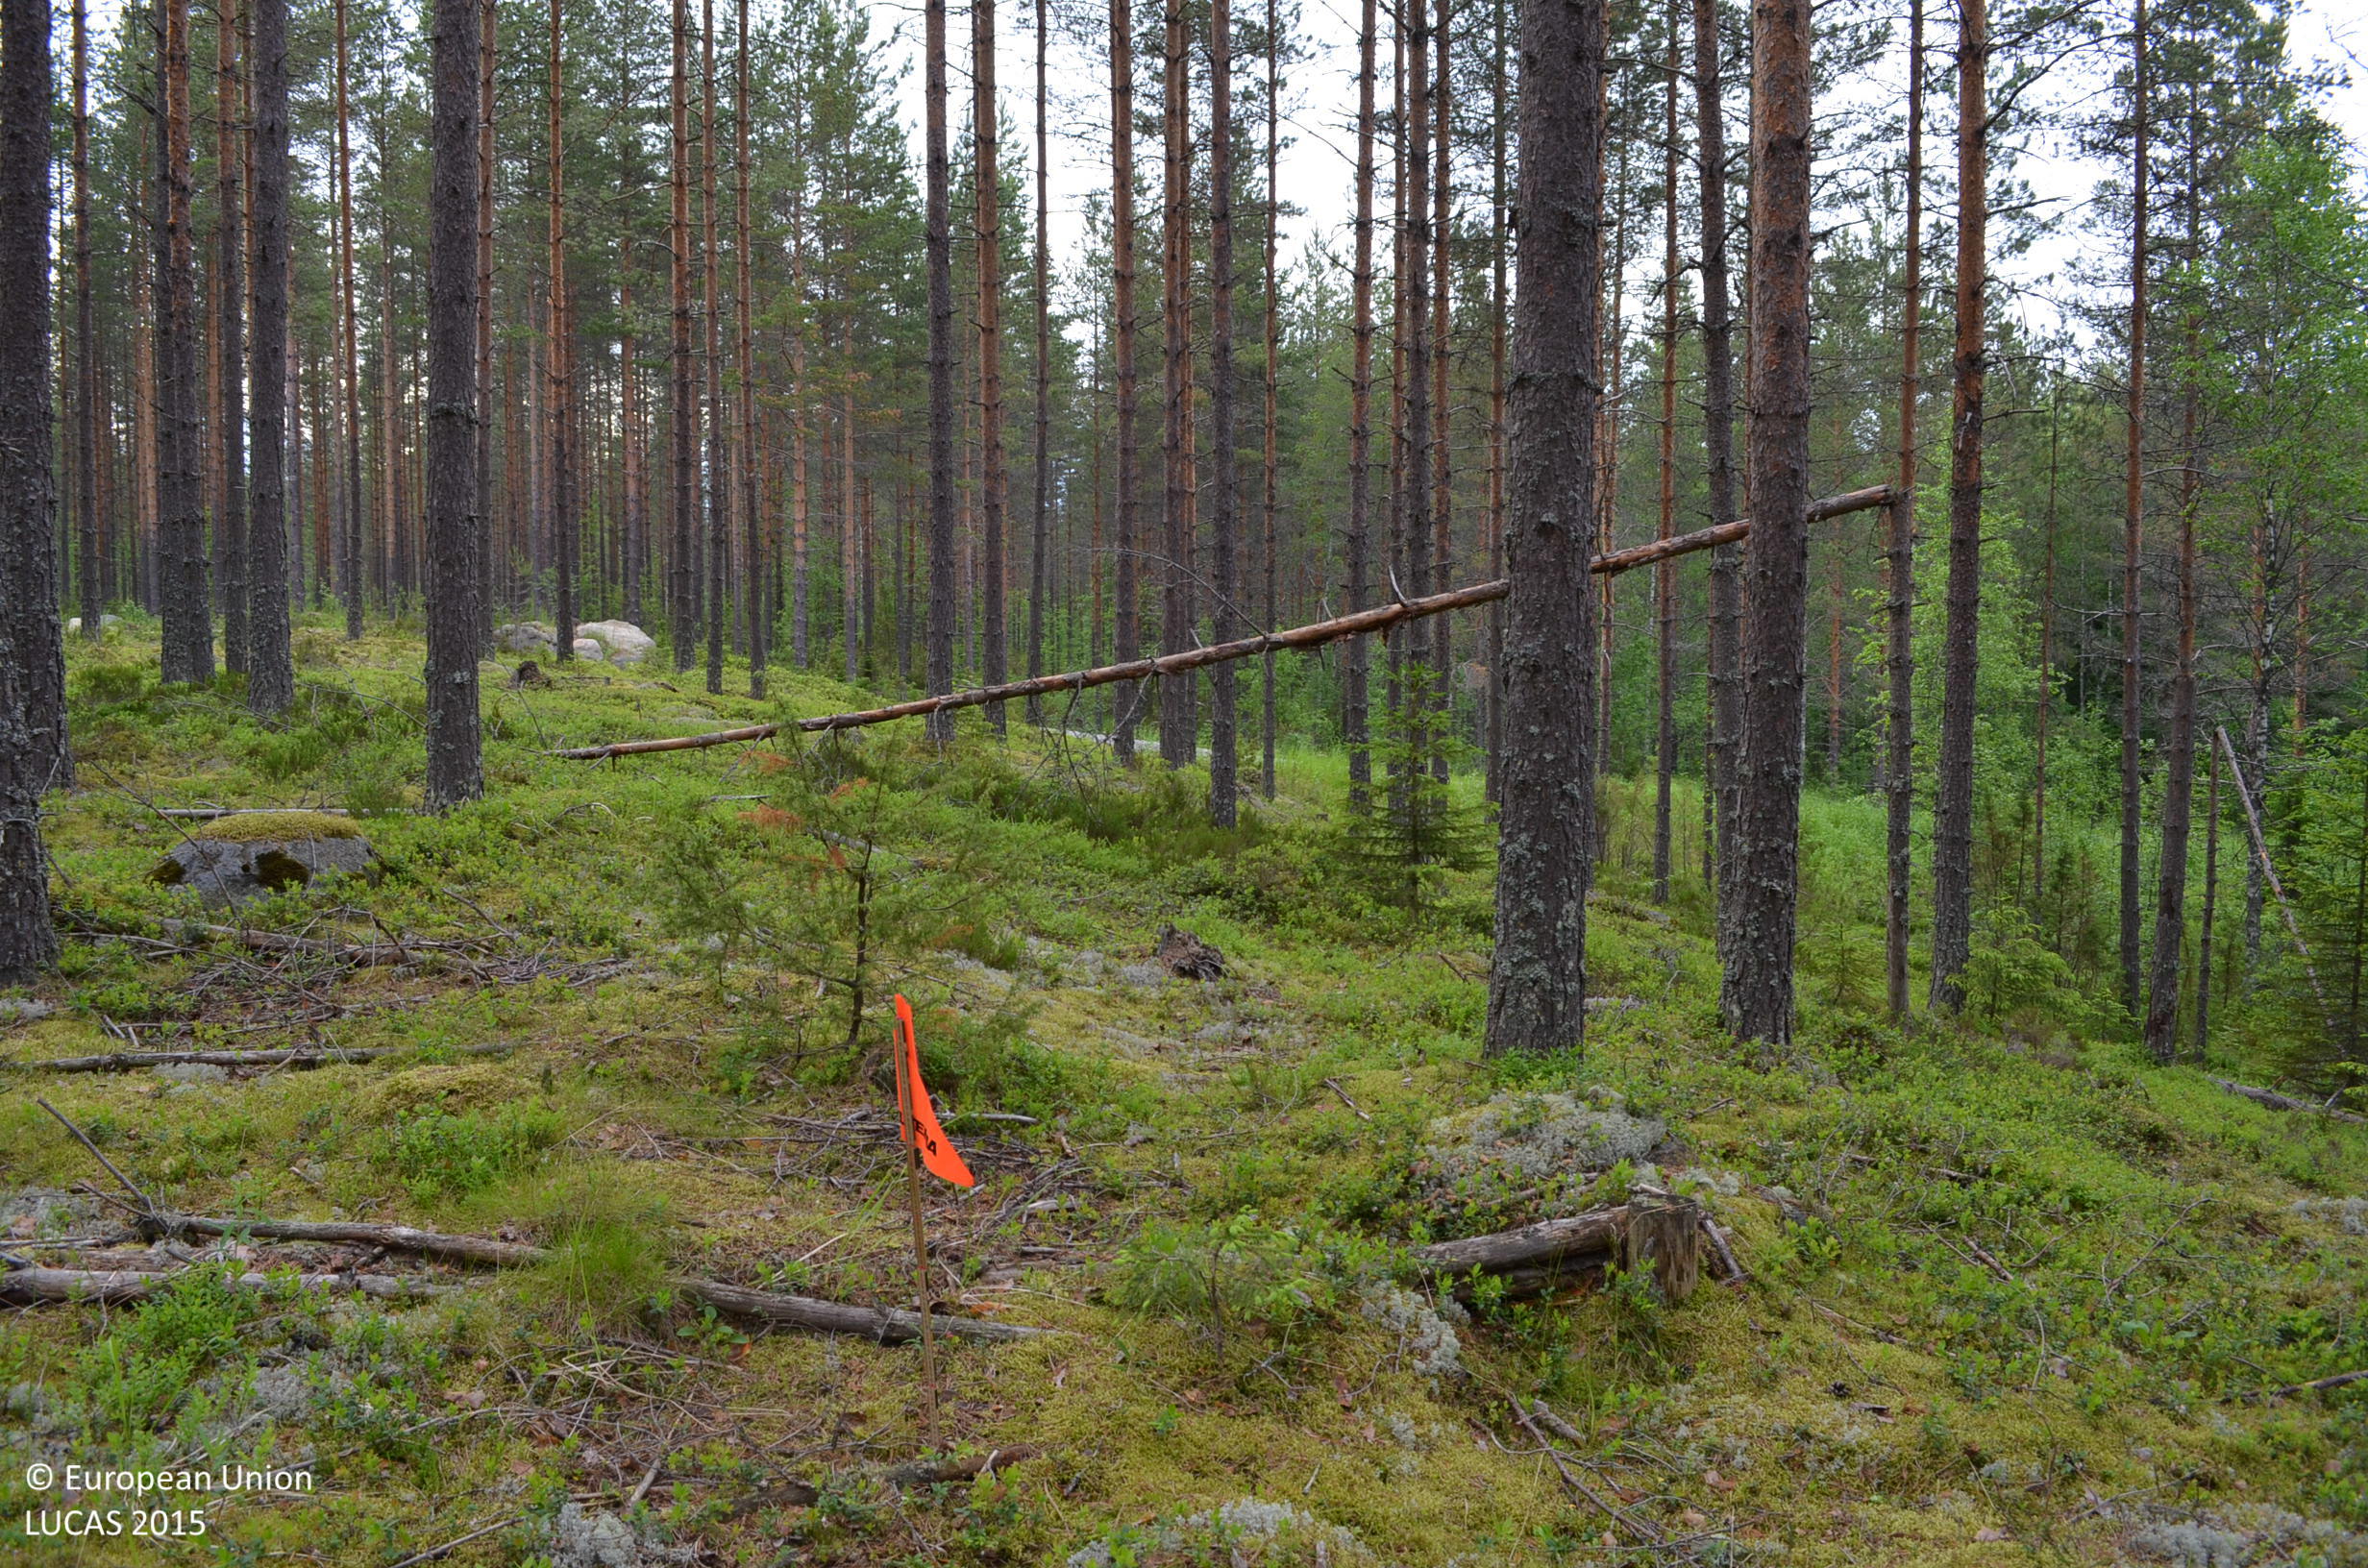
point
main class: Woodland
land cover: Pine dominated coniferous woodland
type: boreal forest
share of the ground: > 75 %
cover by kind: coniferous forest trees 75 %, shrubs 20 %, lichens and mosses 5 %
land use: Forestry
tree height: > 5 m
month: June
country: FI
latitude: 62.0855
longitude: 23.5749
